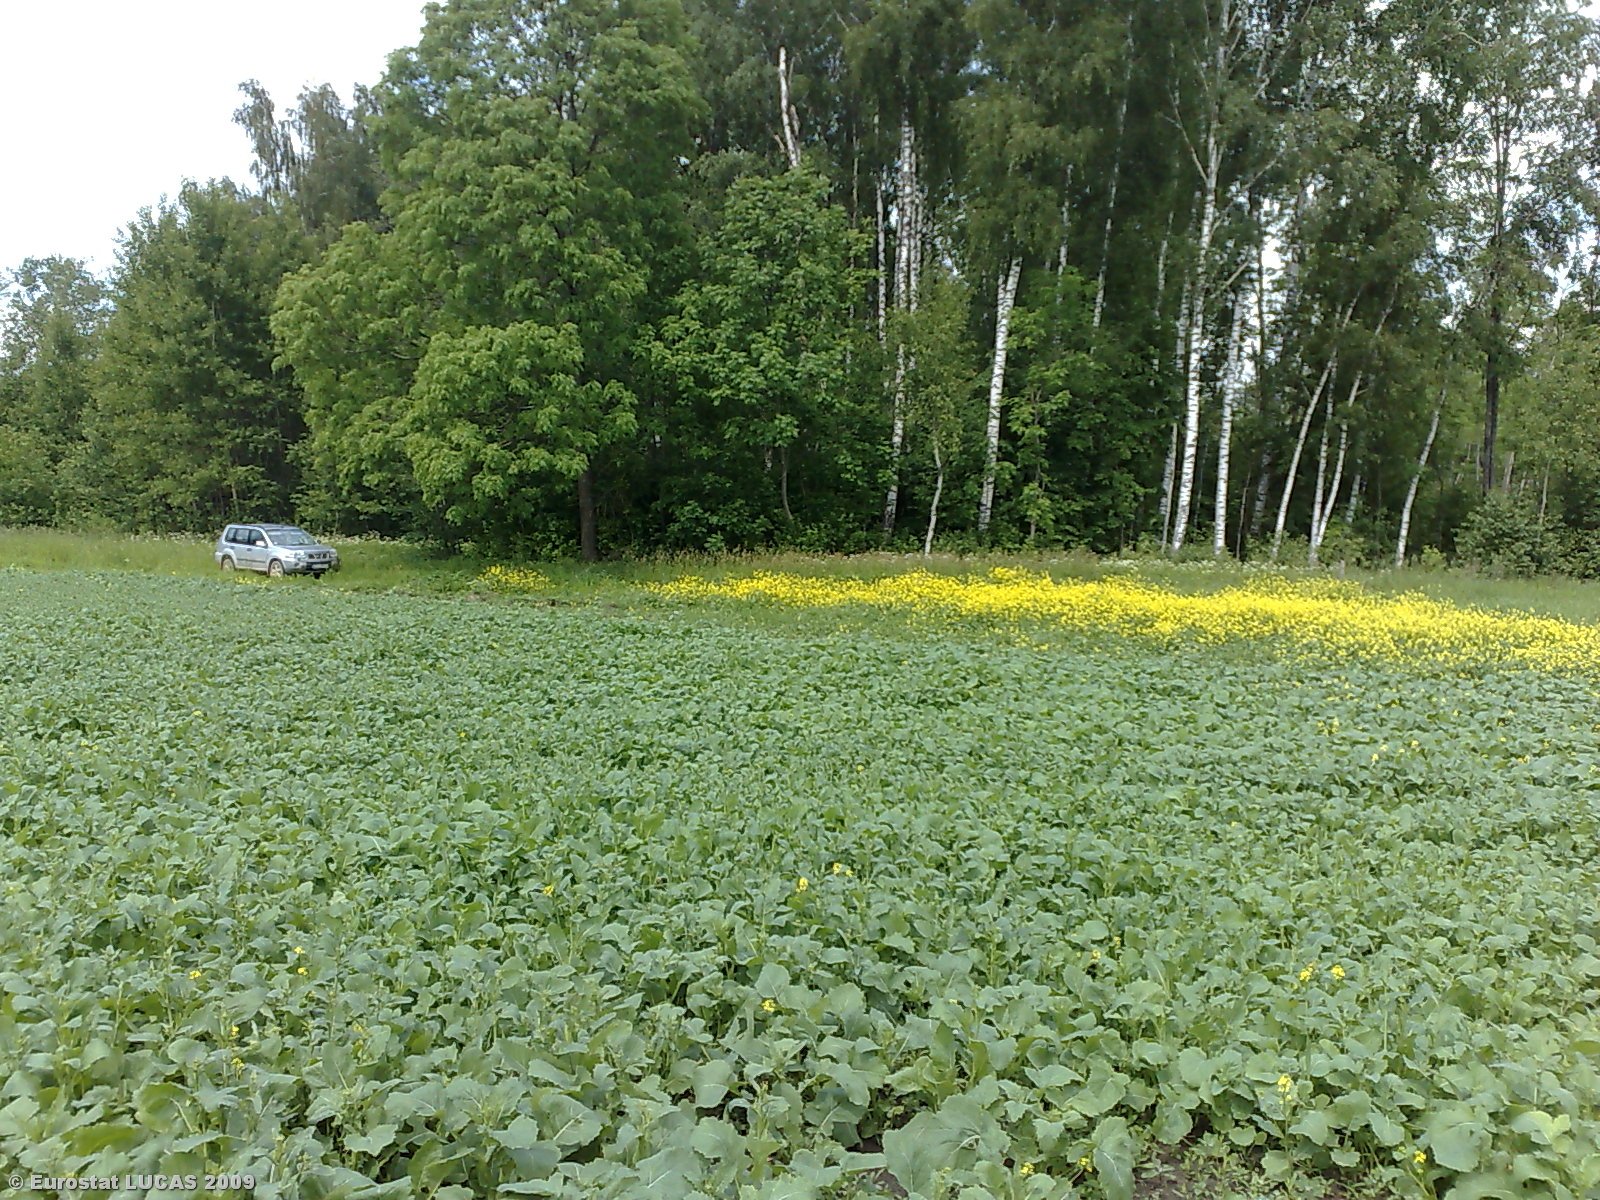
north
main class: Cropland
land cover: Other root crops
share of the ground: > 75 %
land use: Agriculture (excluding fallow land and kitchen gardens)
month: June
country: LT
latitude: 56.1313
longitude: 24.1356
